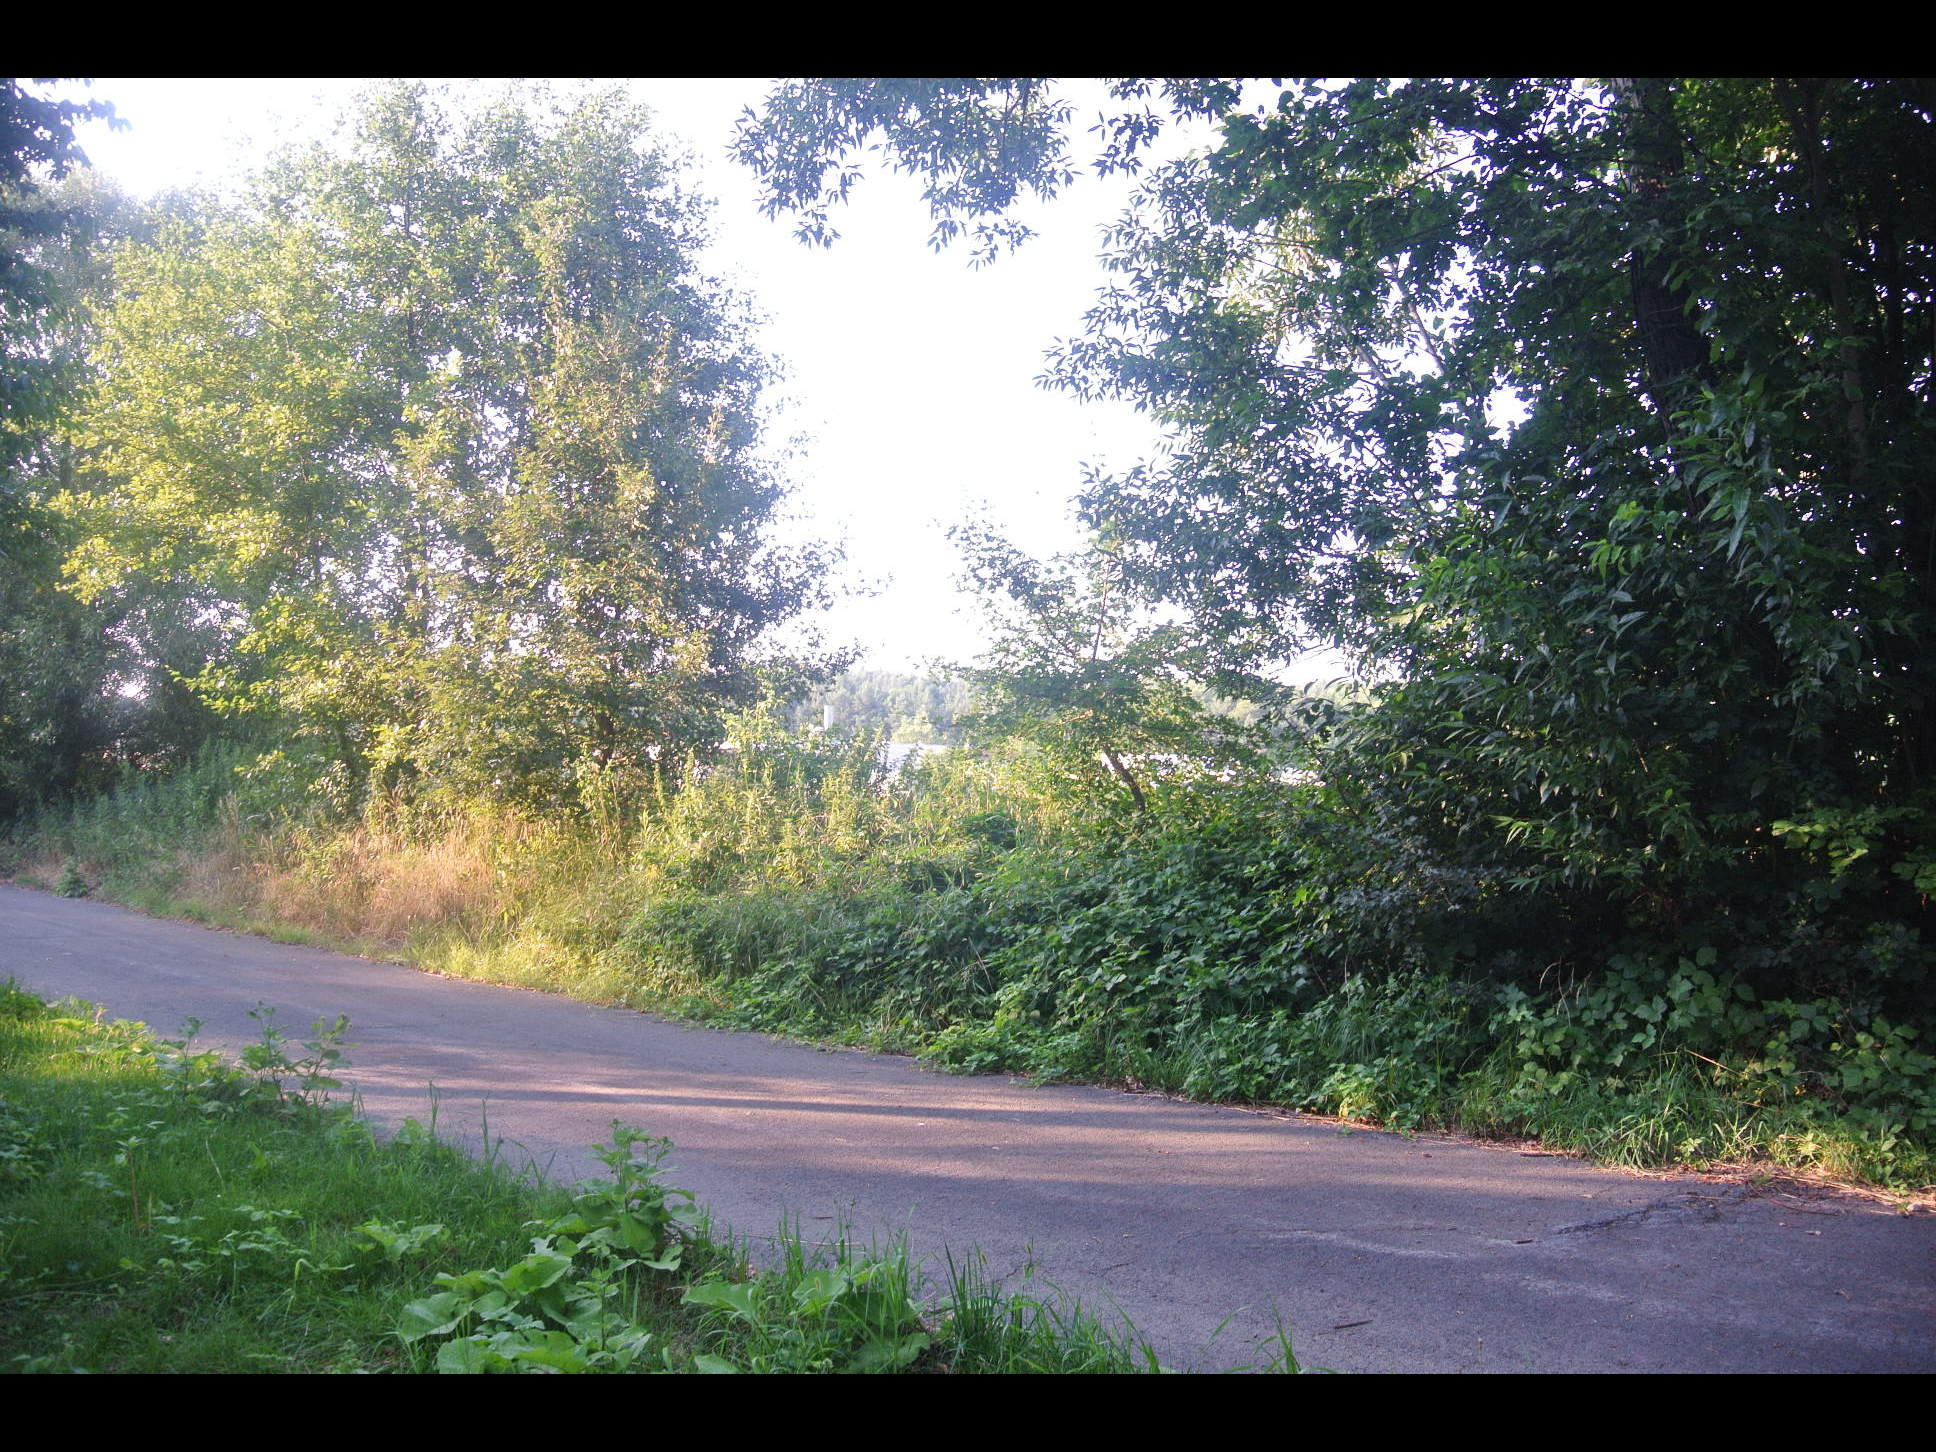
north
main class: Woodland
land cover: Broadleaved woodland
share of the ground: > 75 %
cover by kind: broadleaved forest trees 90 %, shrubs 5 %, herbaceous plants 5 %
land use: Forestry
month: July
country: AT
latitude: 47.5083
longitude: 16.4964
